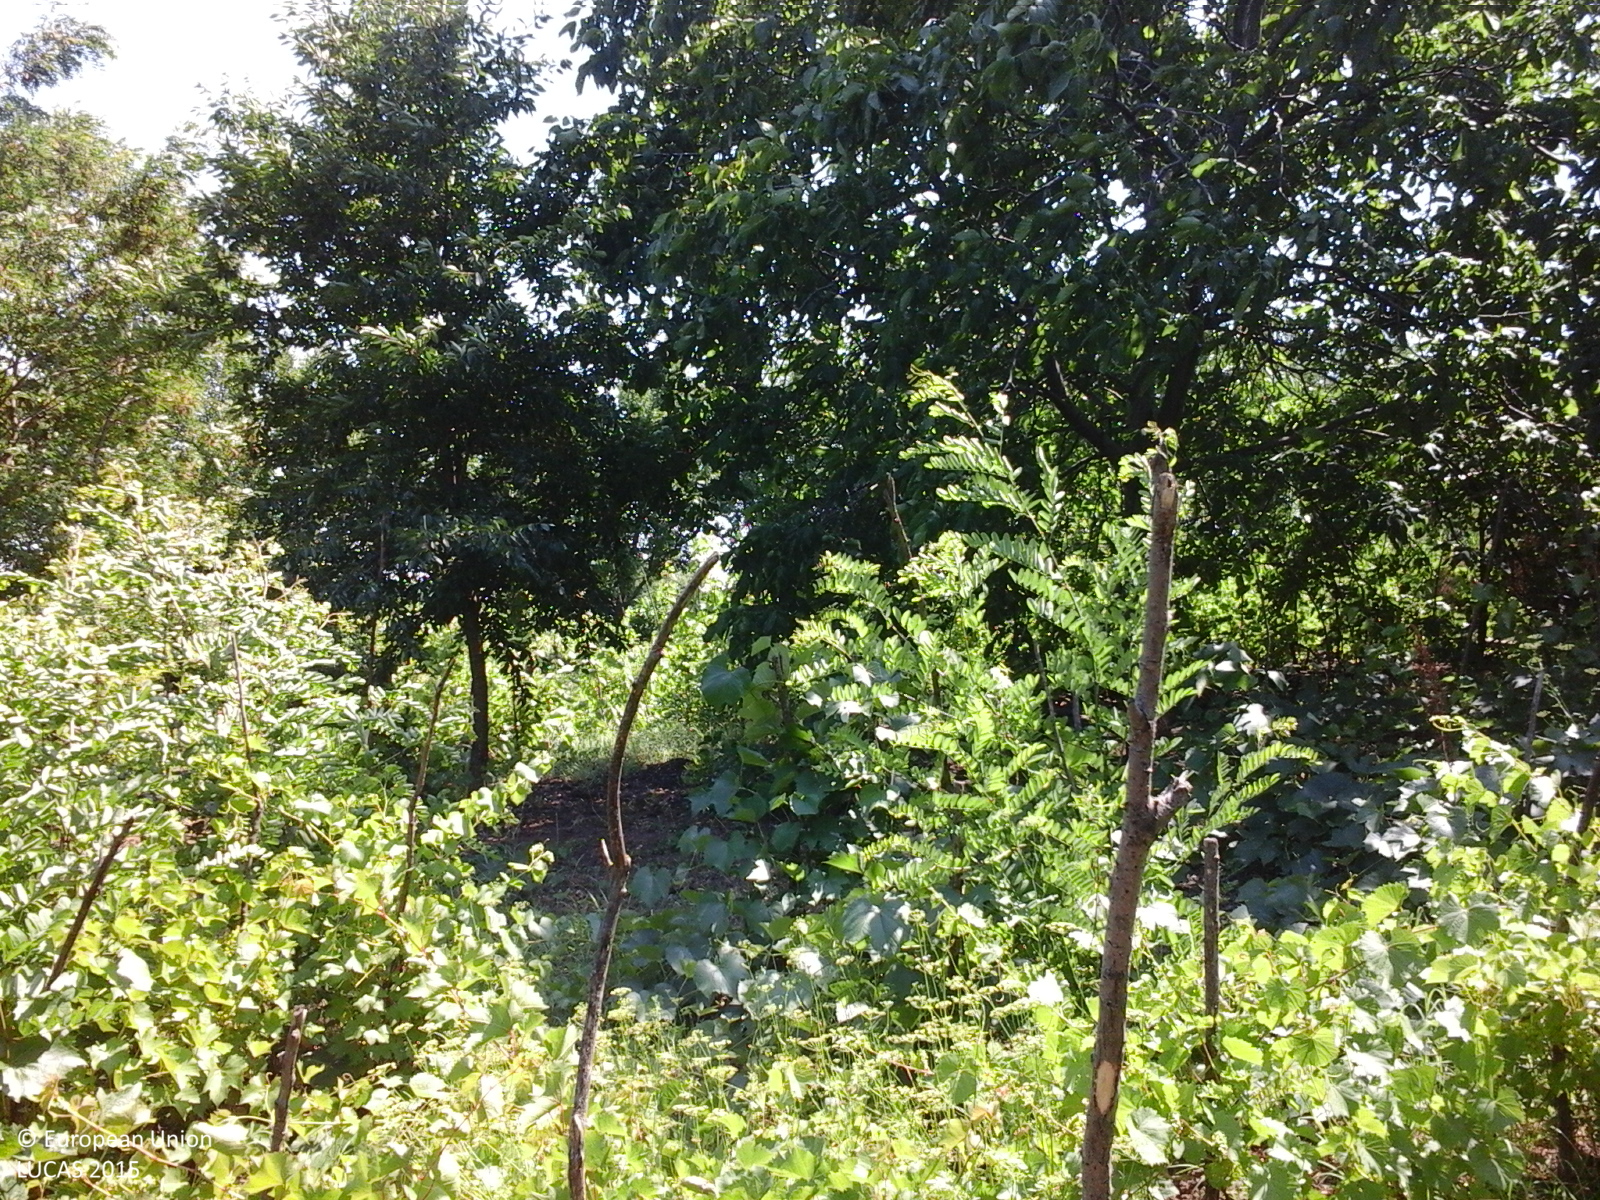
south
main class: Cropland
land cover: Vineyards
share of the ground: > 75 %
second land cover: Other bare soil
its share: > 75 %
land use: Kitchen garden
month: June
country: RO
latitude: 46.8968
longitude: 28.0753
